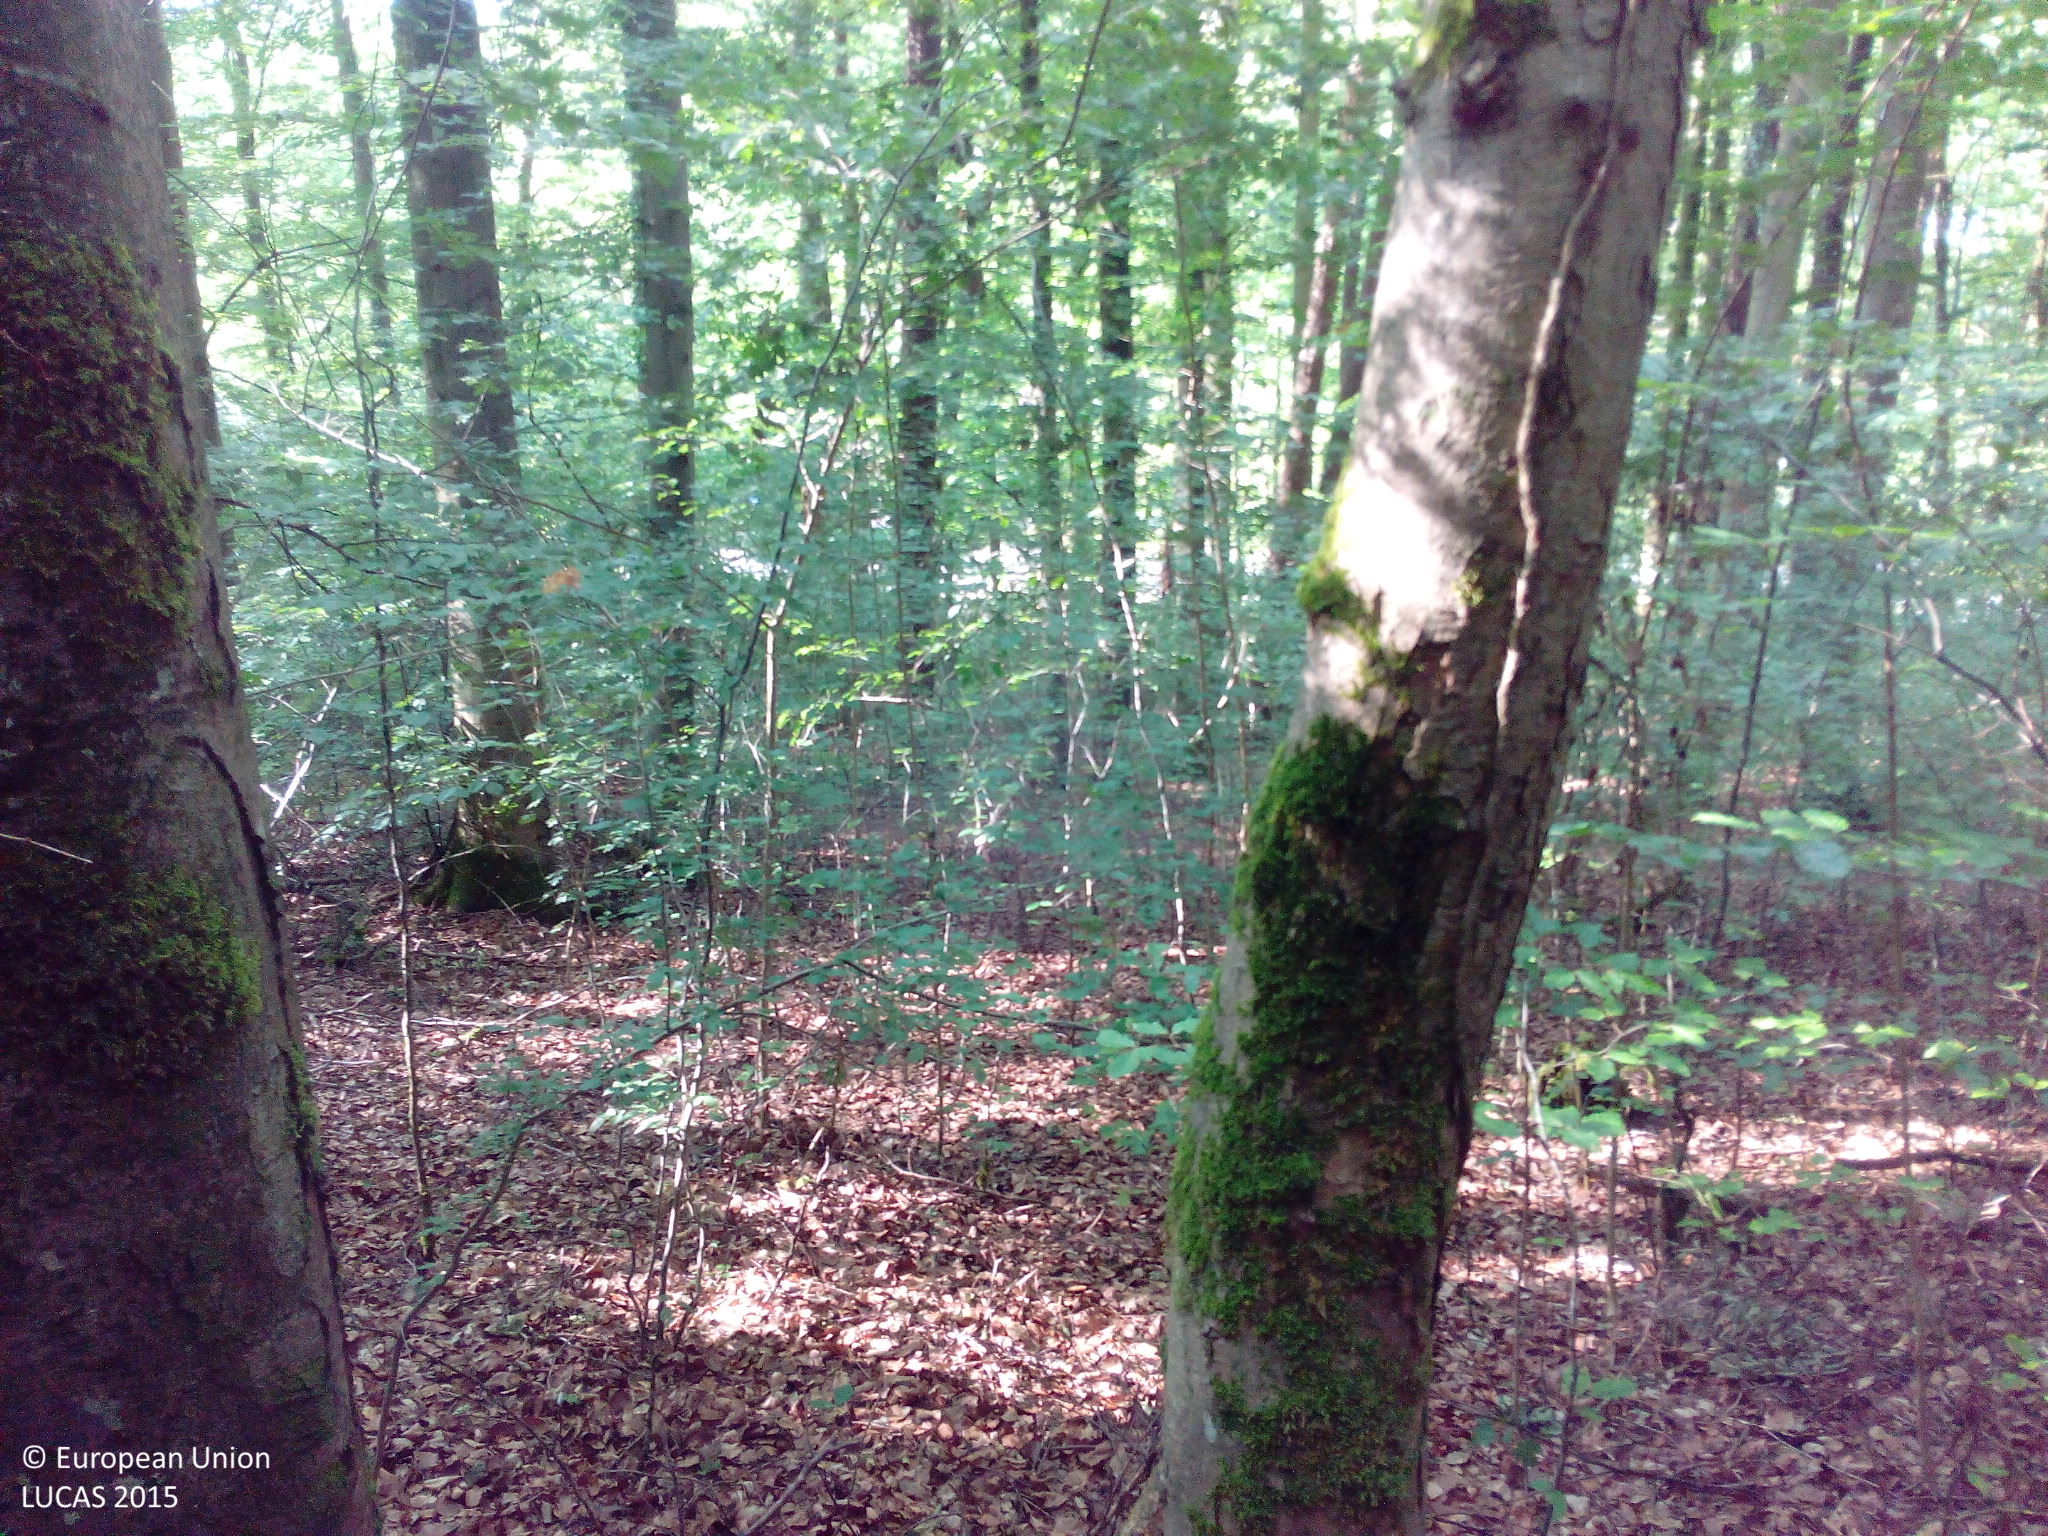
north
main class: Woodland
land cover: Broadleaved woodland
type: mesophytic deciduous forest
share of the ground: > 75 %
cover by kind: broadleaved forest trees 100 %
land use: Forestry
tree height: > 5 m
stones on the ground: < 10 %
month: July
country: DE
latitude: 49.7706
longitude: 9.9028
